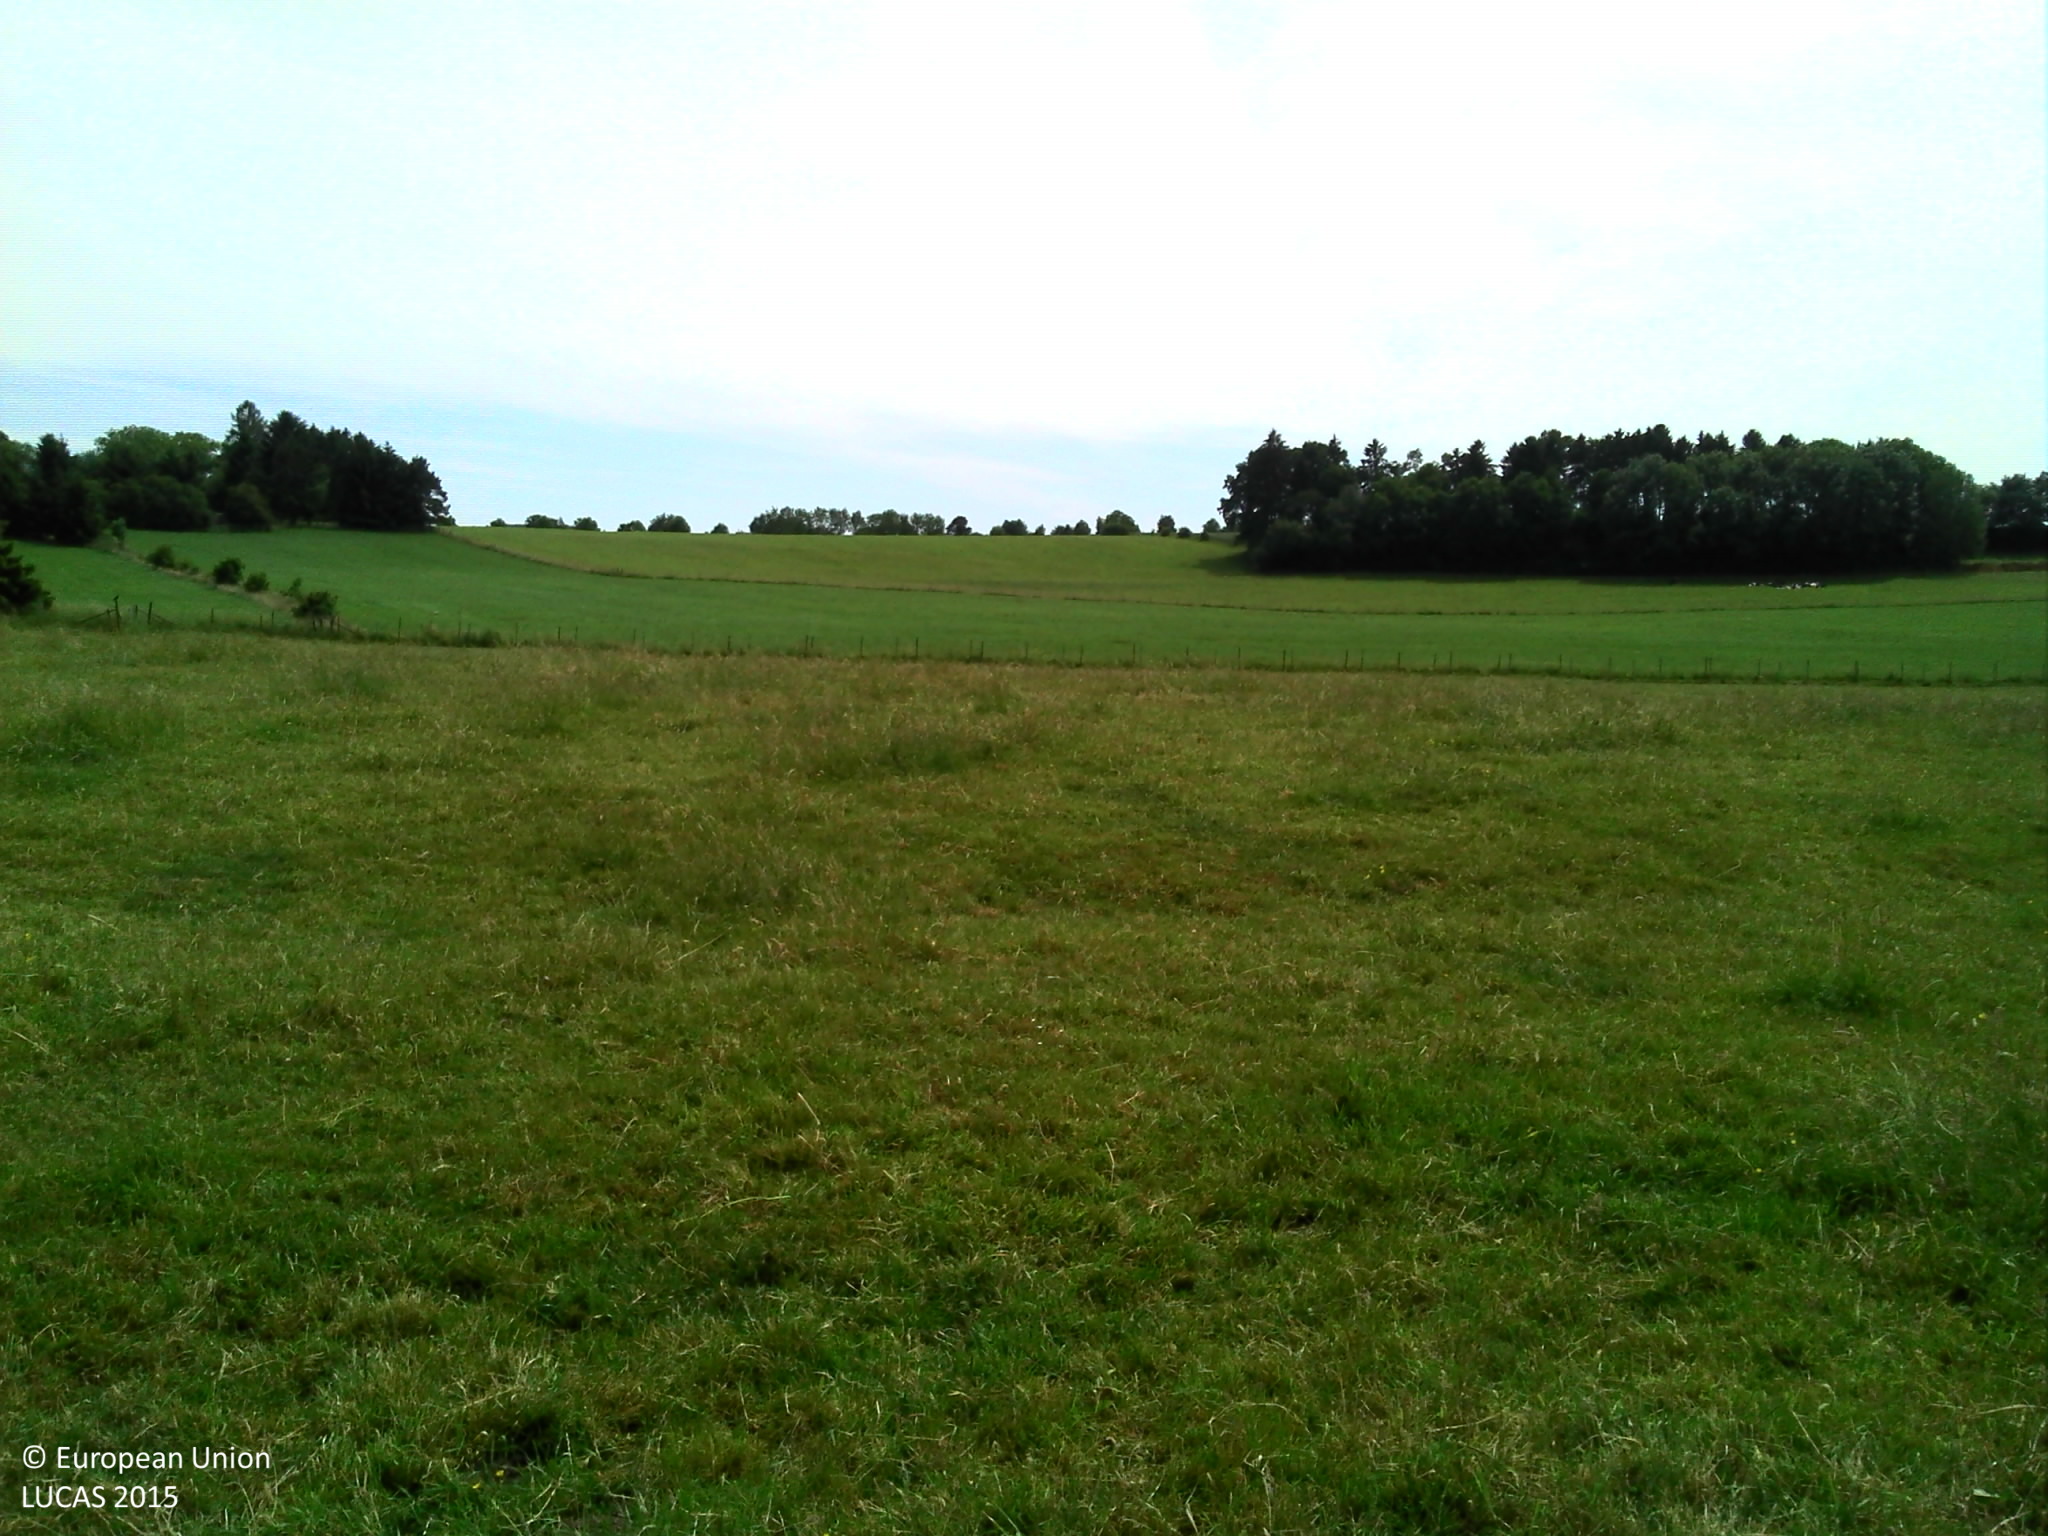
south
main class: Grassland
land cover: Grassland without tree/shrub cover
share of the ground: > 75 %
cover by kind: herbaceous plants 100 %
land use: Agriculture (excluding fallow land and kitchen gardens)
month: June
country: LU
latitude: 49.6429
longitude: 5.9138
